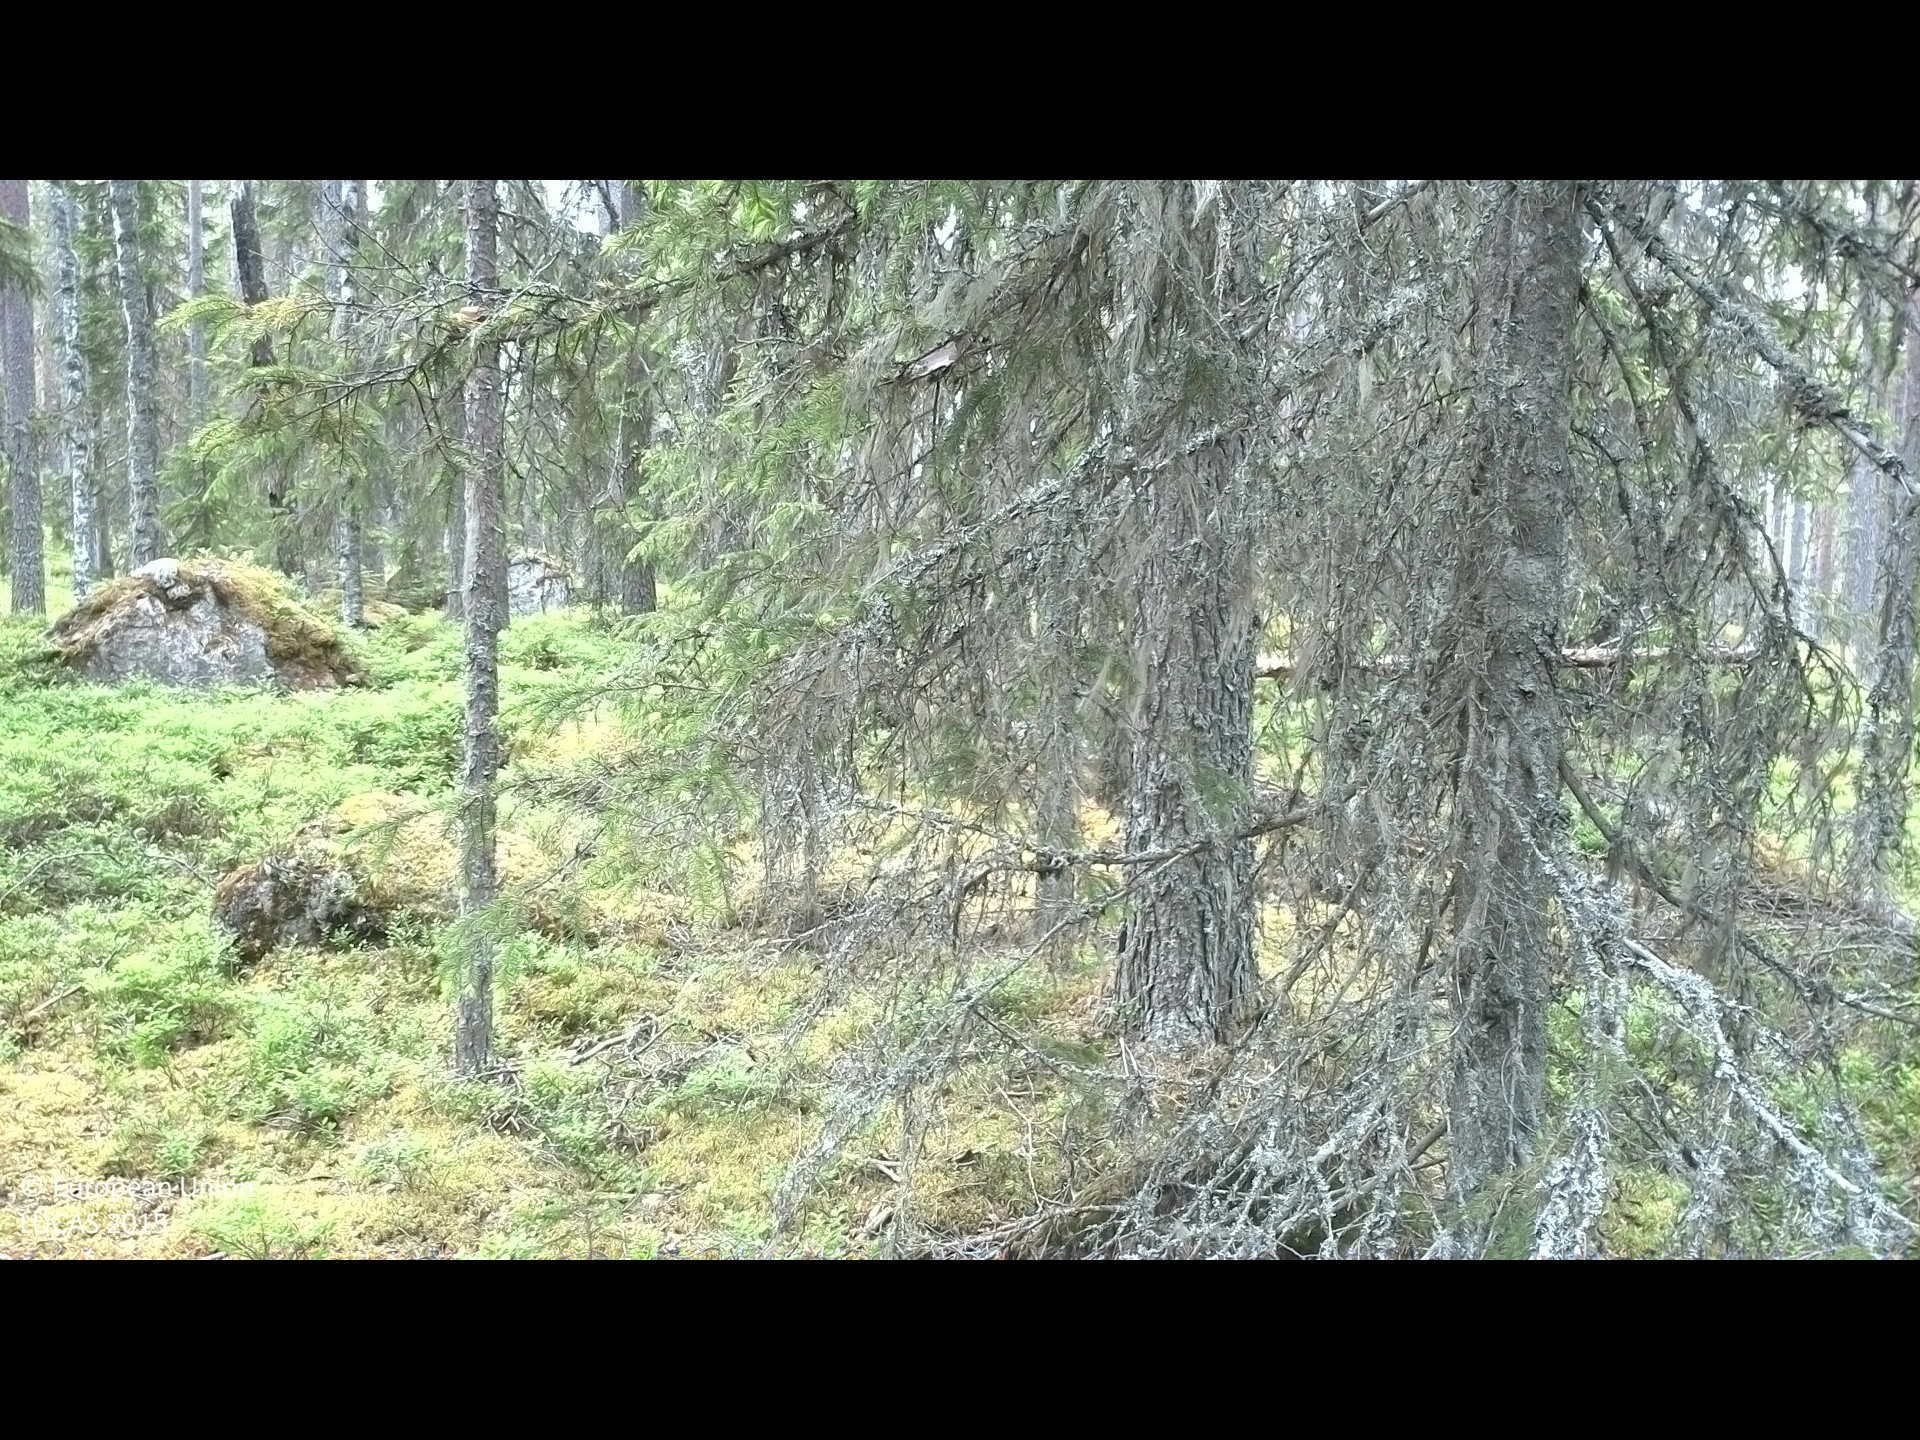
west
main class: Woodland
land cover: Pine dominated coniferous woodland
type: boreal forest
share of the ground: 25 - 50 %
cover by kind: coniferous forest trees 45 %, lichens and mosses 25 %, shrubs 20 %, broadleaved forest trees 10 %
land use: Forestry
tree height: > 5 m
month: June
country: SE
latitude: 61.9610
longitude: 16.1794
